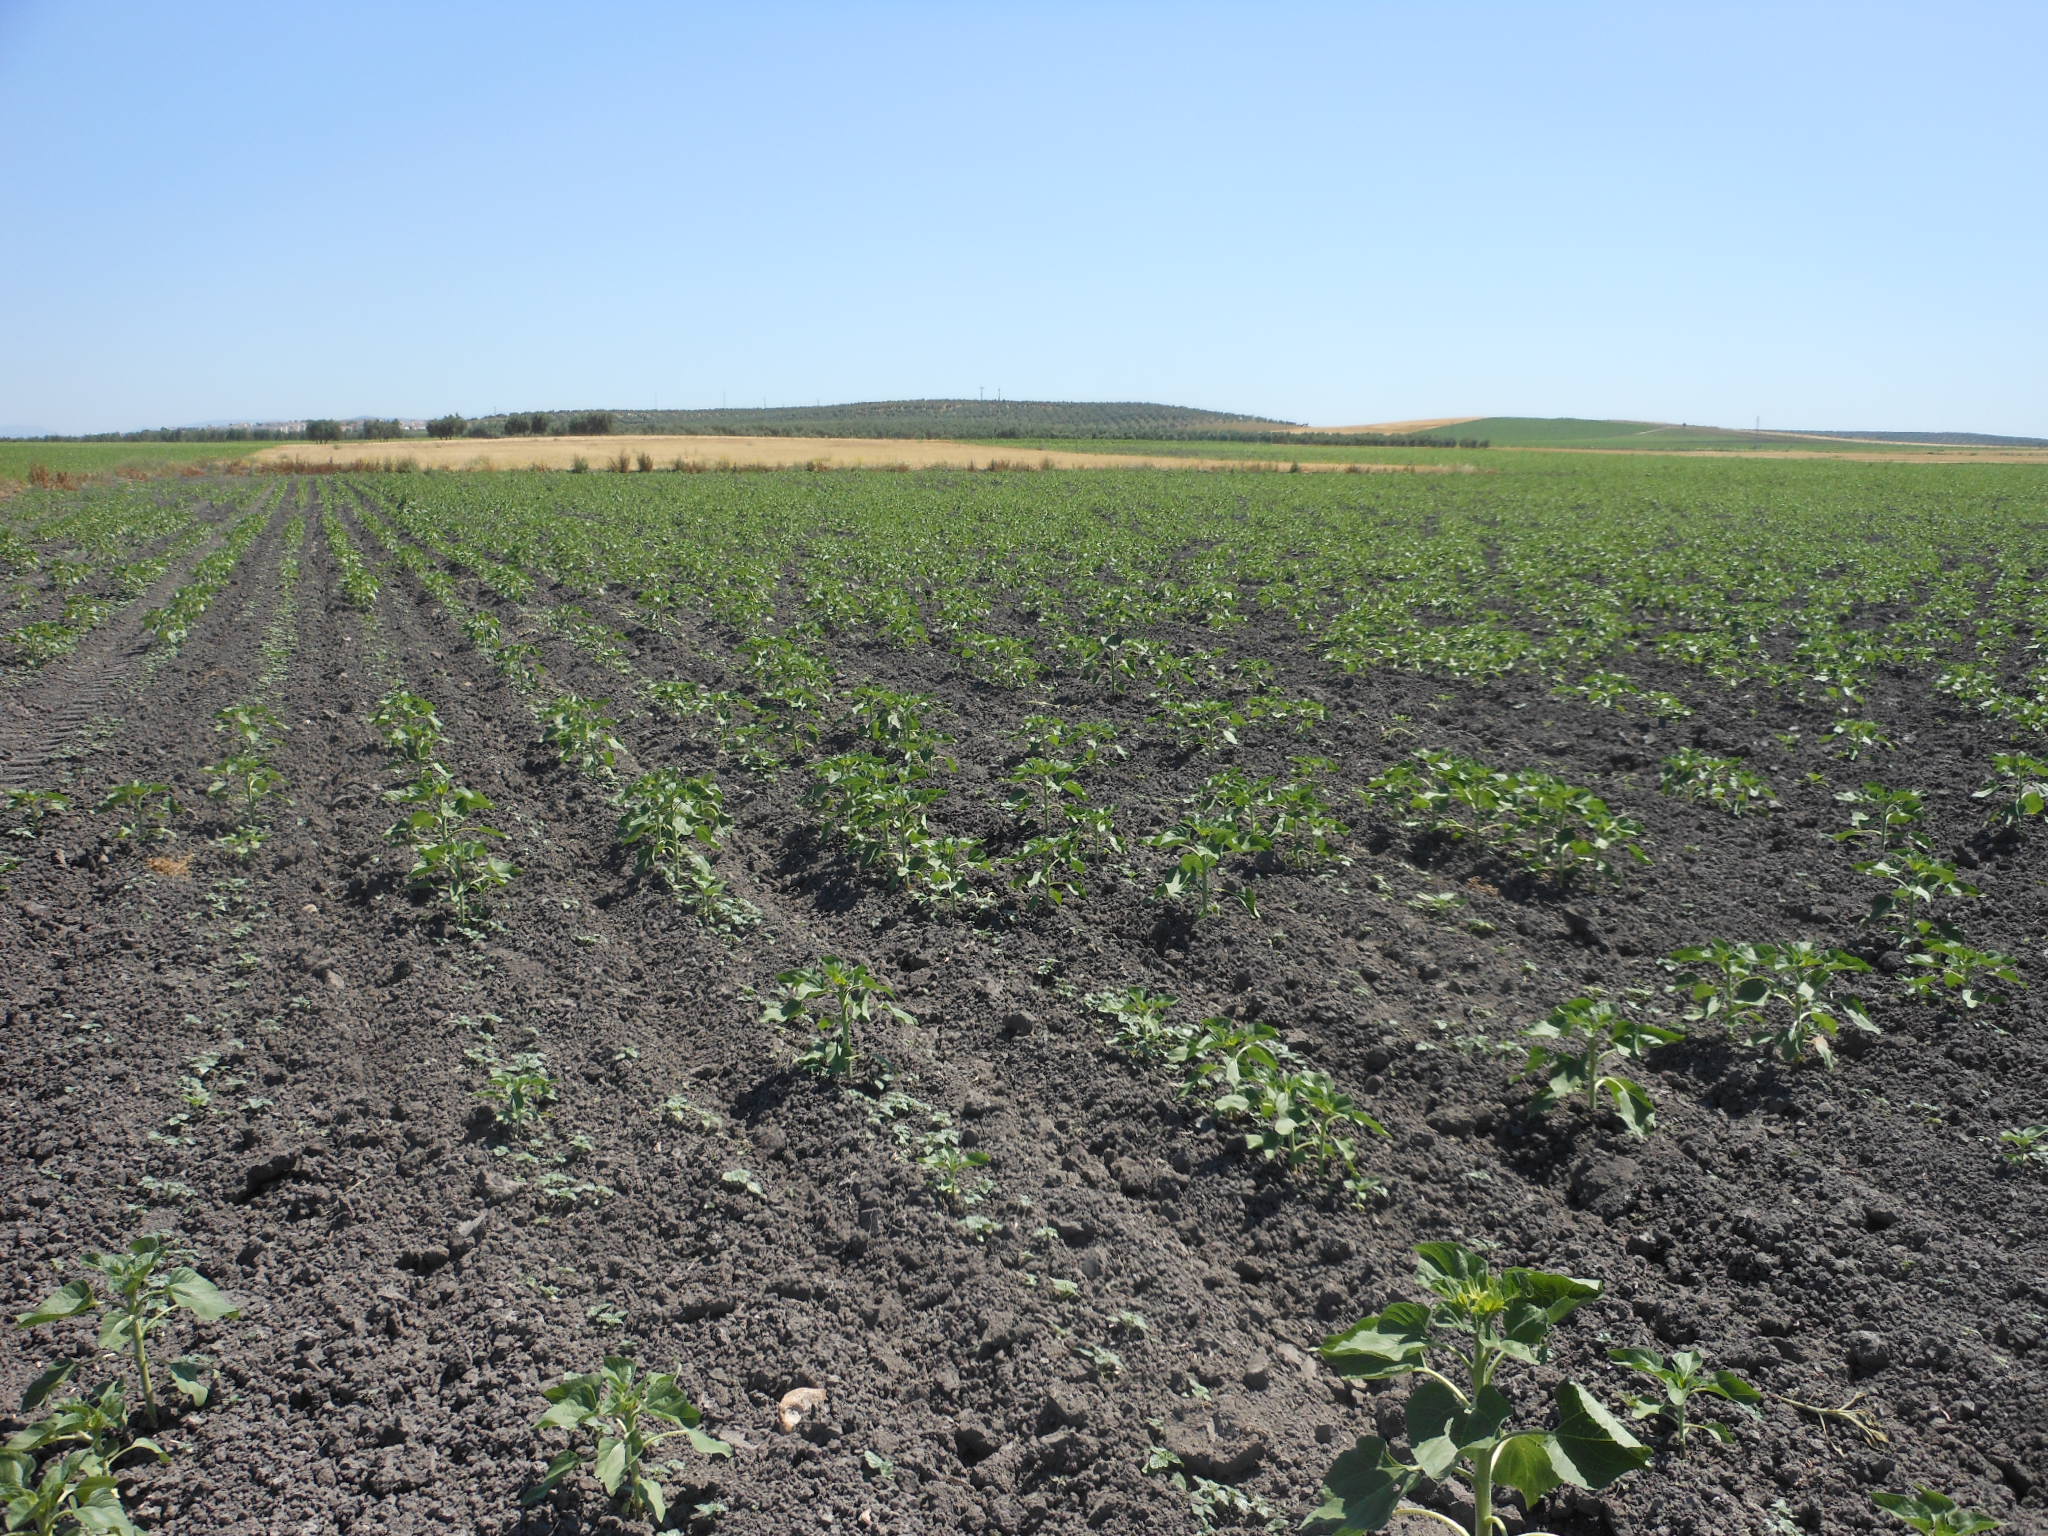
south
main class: Cropland
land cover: Sunflower
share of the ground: 10 - 25 %
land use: Agriculture (excluding fallow land and kitchen gardens)
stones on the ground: < 10 %
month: May
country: ES
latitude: 37.2895
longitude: -5.5473
